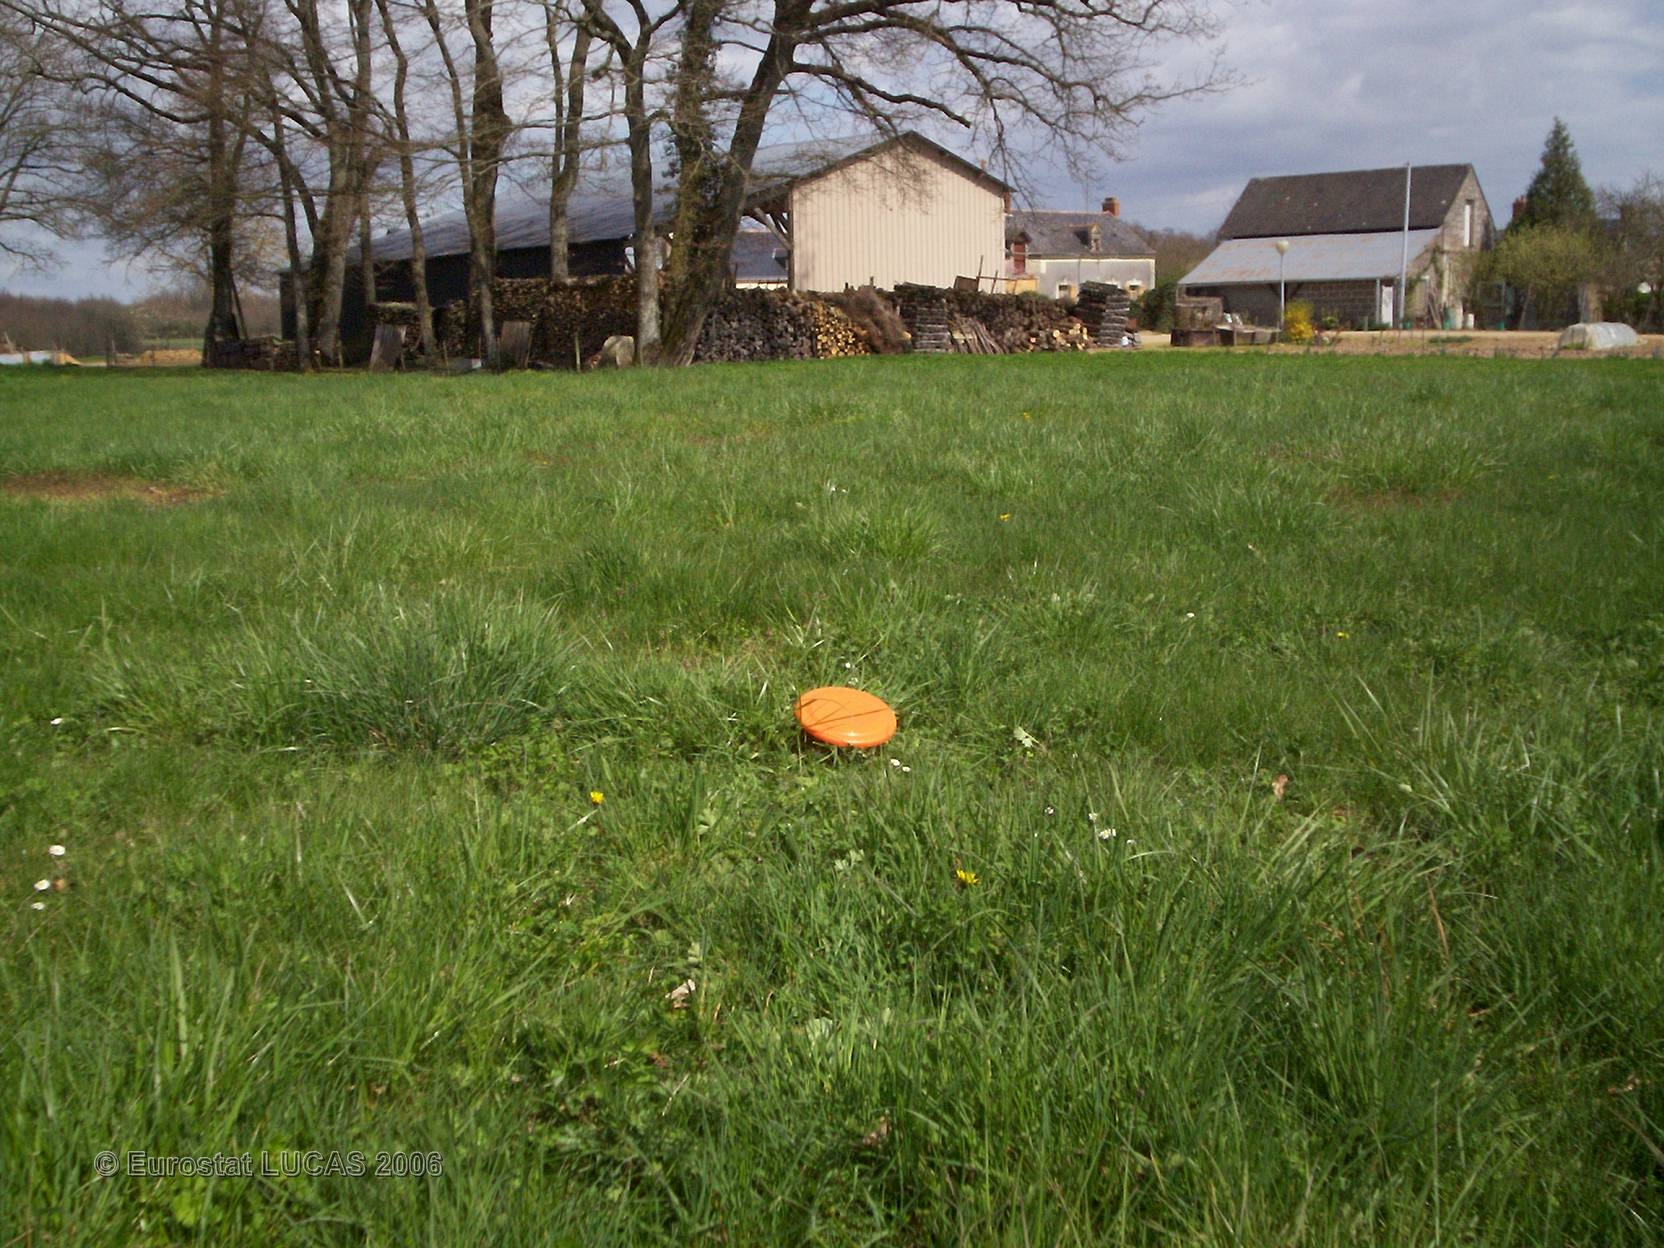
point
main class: Grassland
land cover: Grassland without tree/shrub cover
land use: Agriculture (excluding fallow land and kitchen gardens)
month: April
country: FR
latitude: 47.3676
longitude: -0.3979
